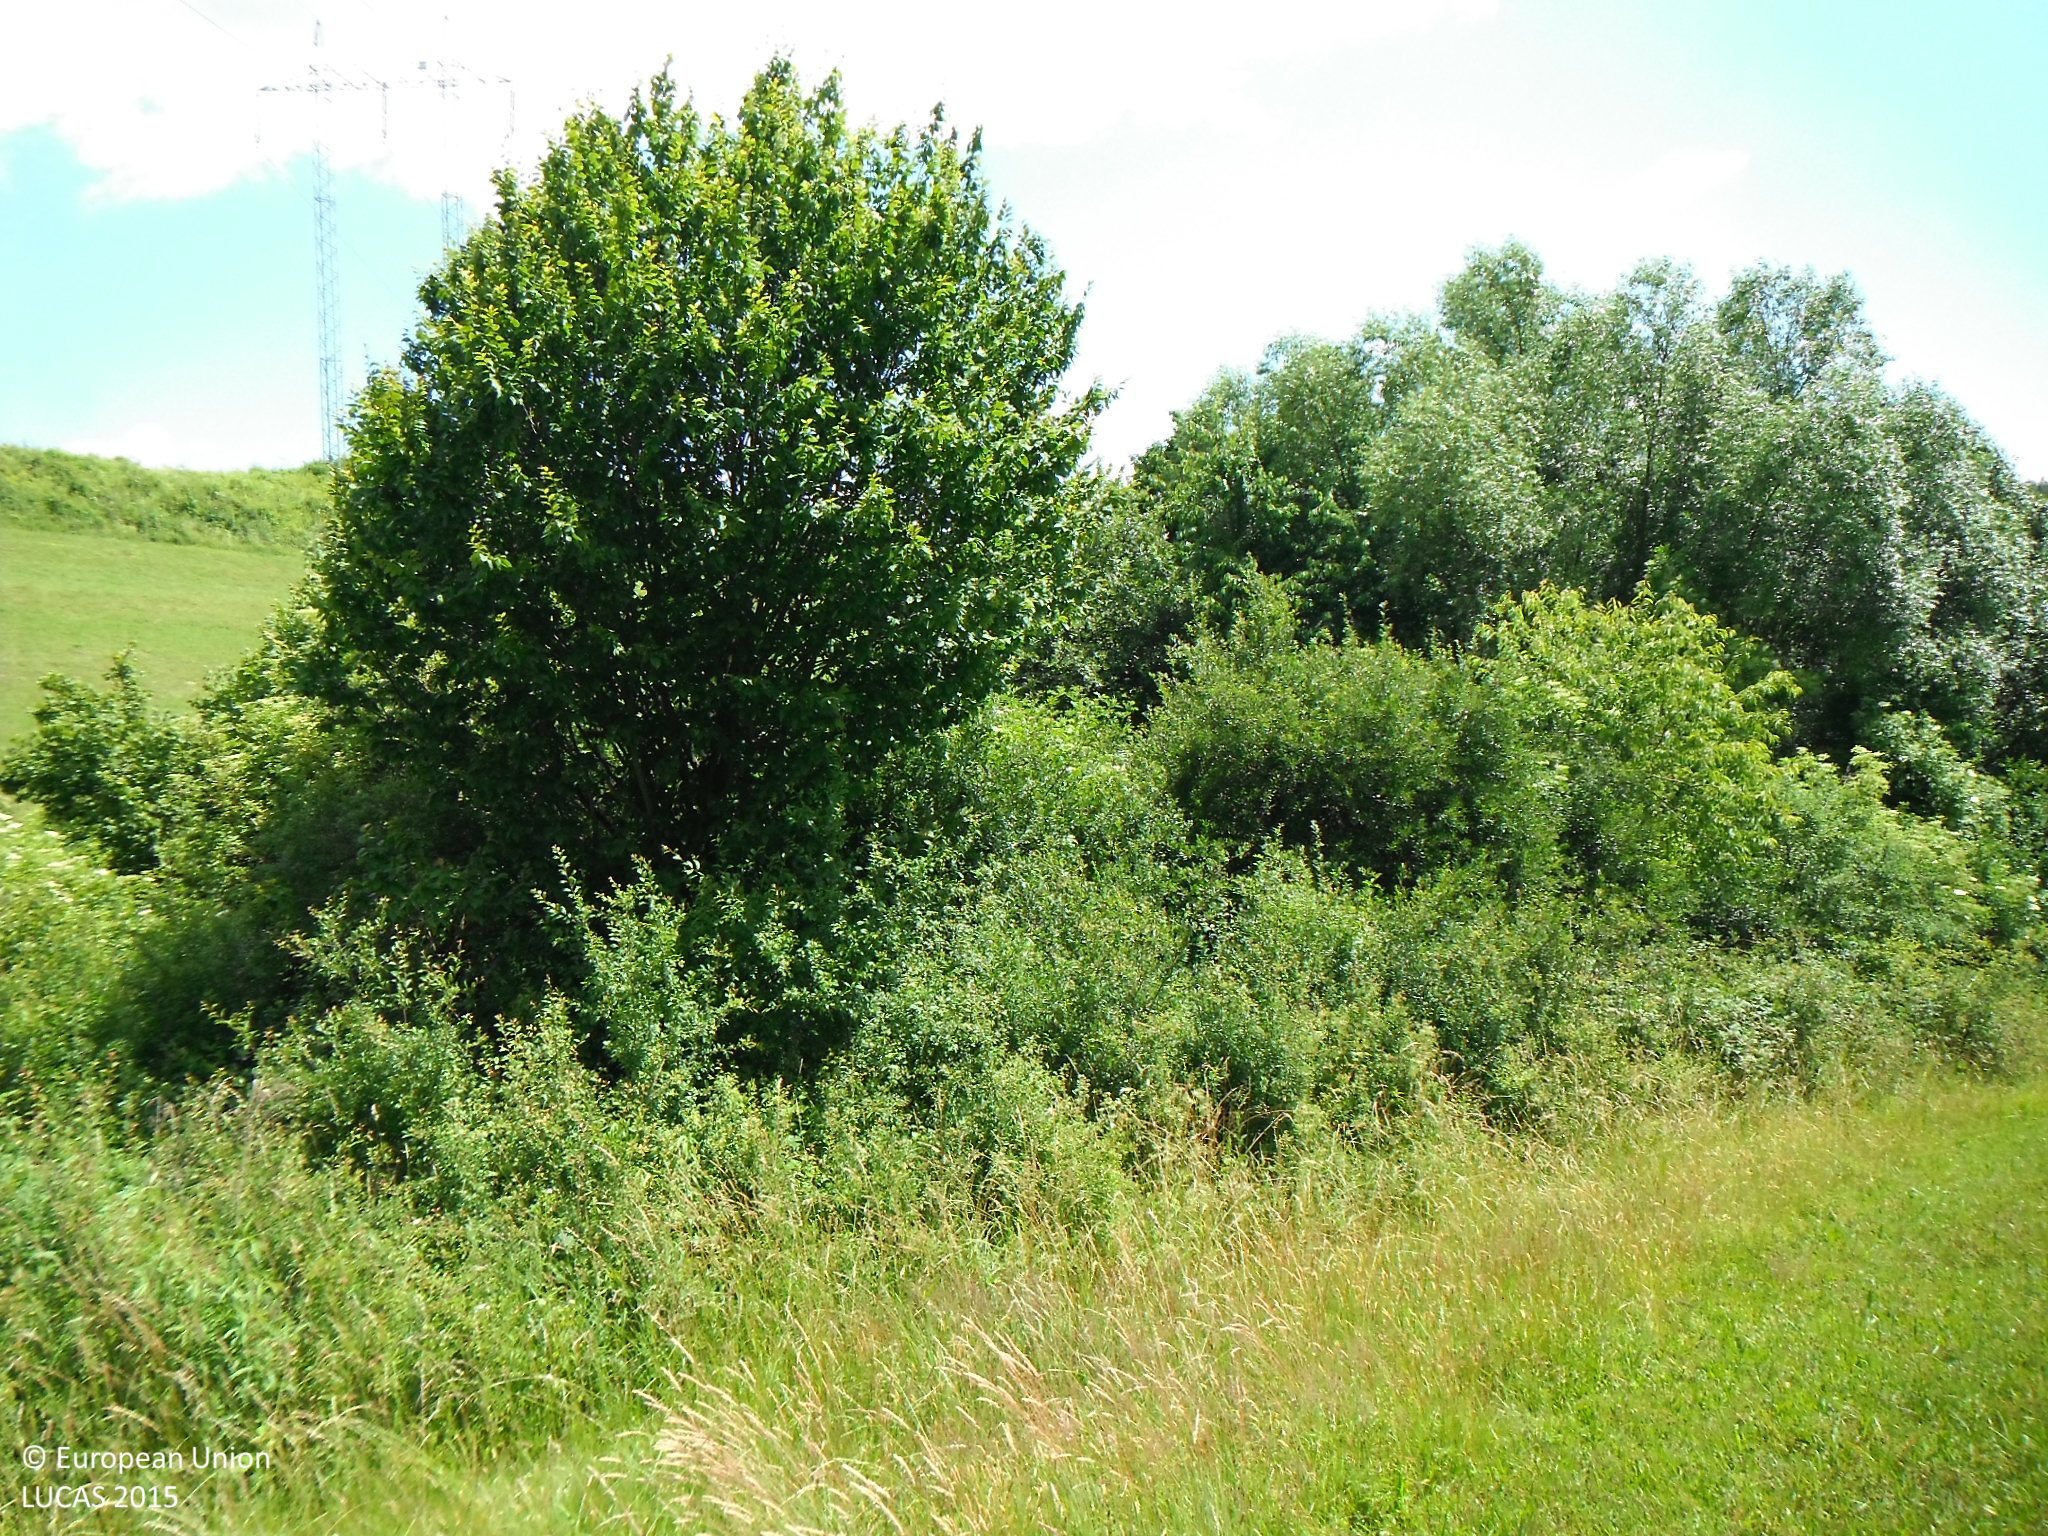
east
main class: Grassland
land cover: Grassland without tree/shrub cover
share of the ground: > 75 %
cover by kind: herbaceous plants 100 %
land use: Agriculture (excluding fallow land and kitchen gardens)
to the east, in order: Grassland without tree/shrub cover; Broadleaved woodland; Grassland without tree/shrub cover; Shrubland without tree cover; Grassland without tree/shrub cover; Electric lines; Grassland without tree/shrub cover
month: June
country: SK
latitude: 48.9078
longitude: 21.1633
